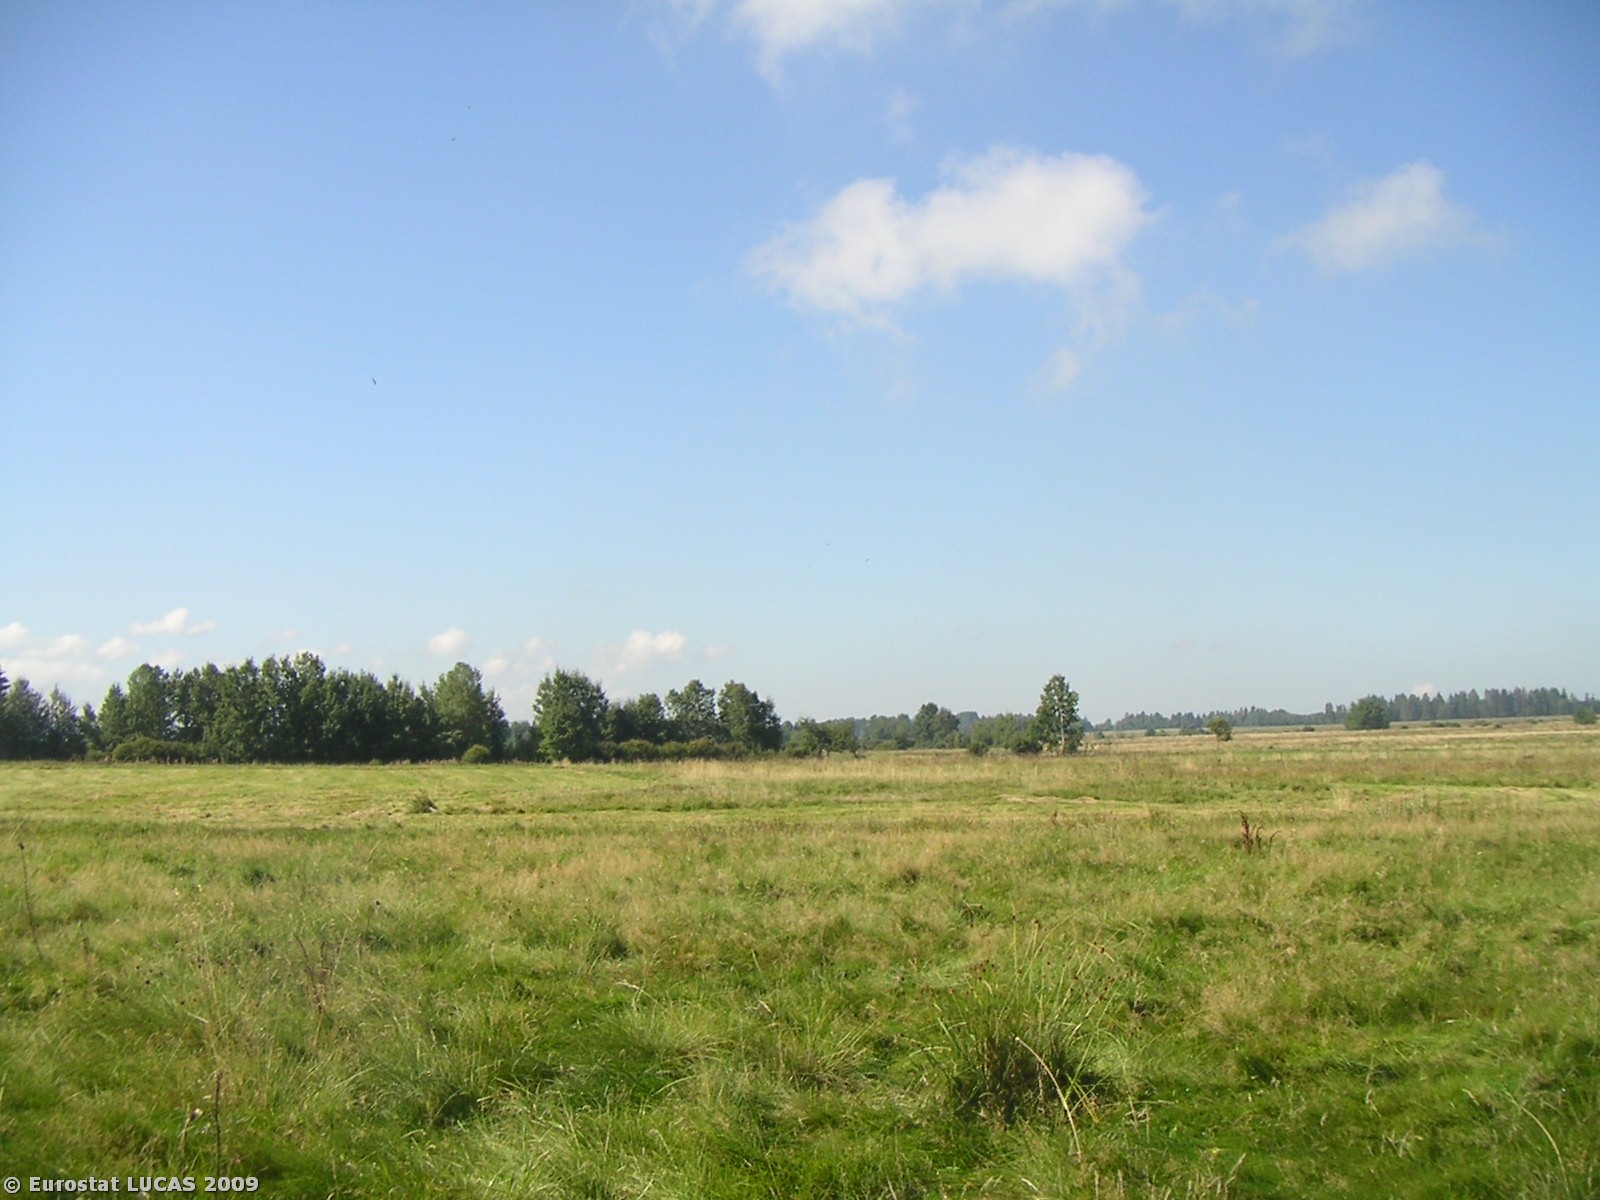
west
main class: Grassland
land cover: Spontaneously vegetated surfaces
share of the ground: > 75 %
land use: Fallow land
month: September
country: PL
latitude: 49.4118
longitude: 19.8574
